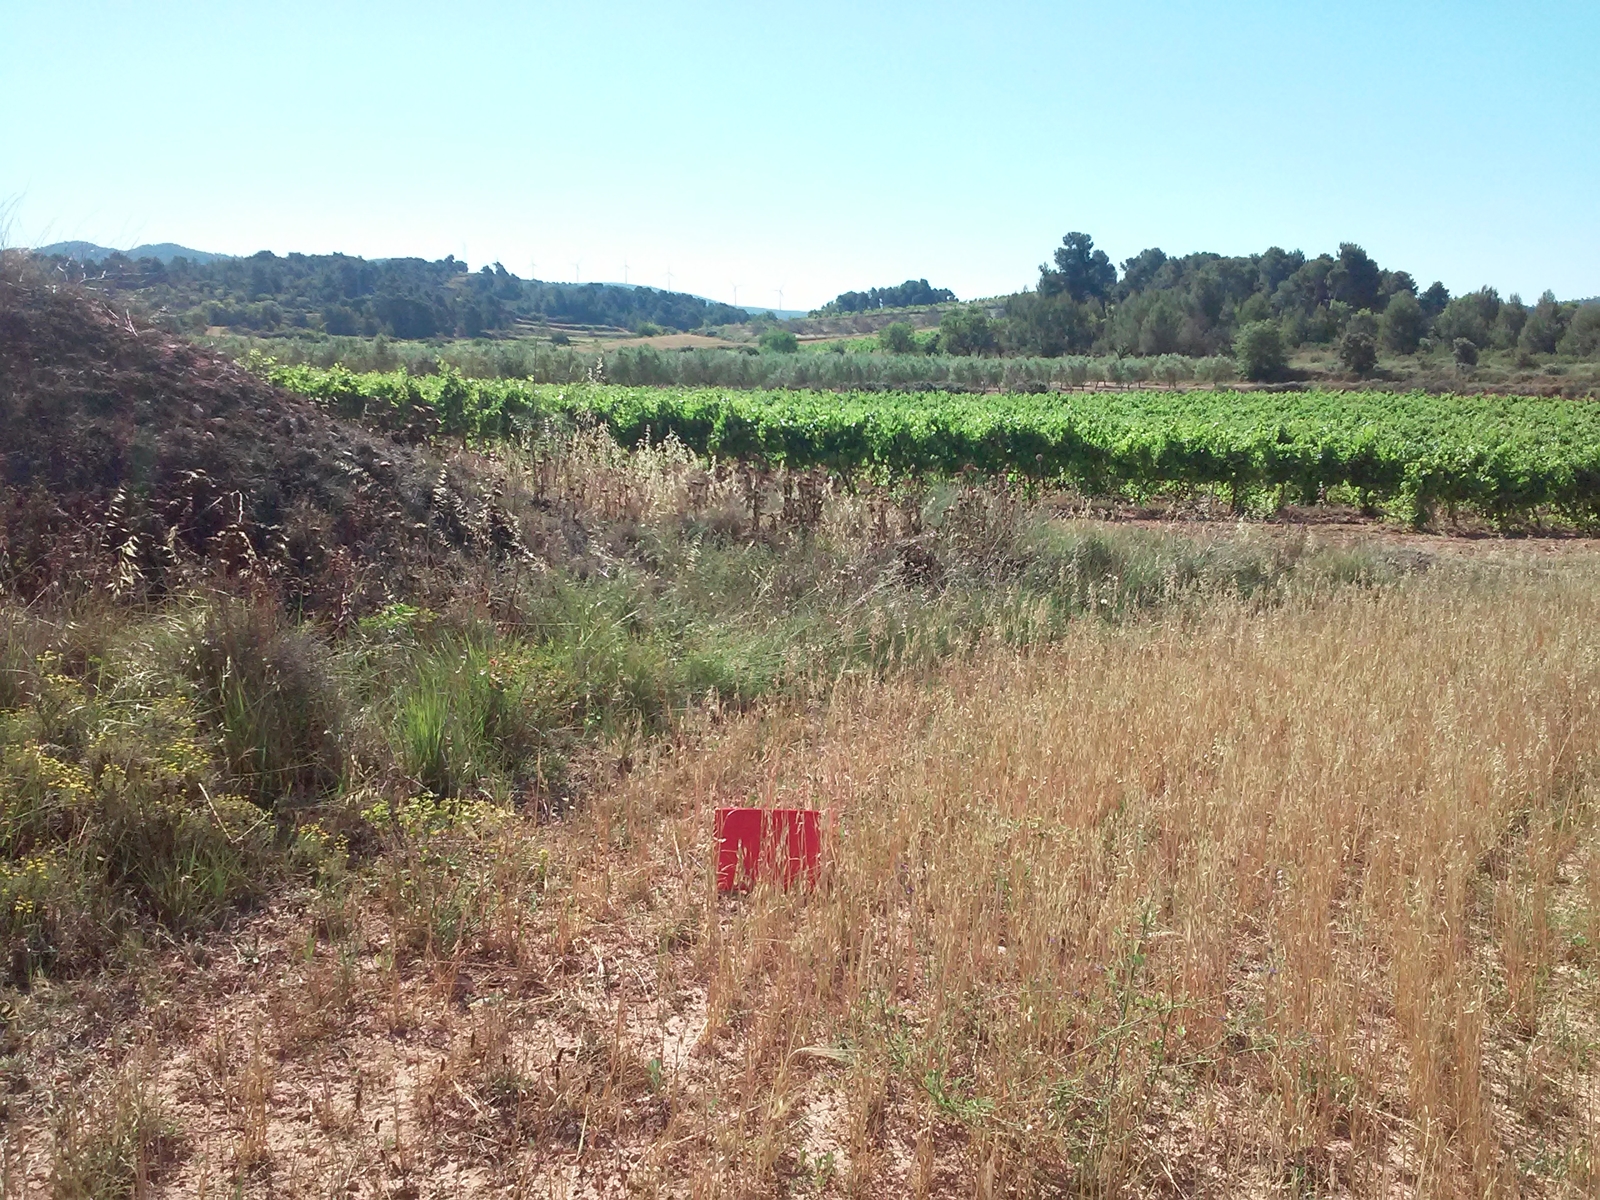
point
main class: Cropland
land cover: Oats
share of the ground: > 75 %
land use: Agriculture (excluding fallow land and kitchen gardens)
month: June
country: ES
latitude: 41.4207
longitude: 1.2453
